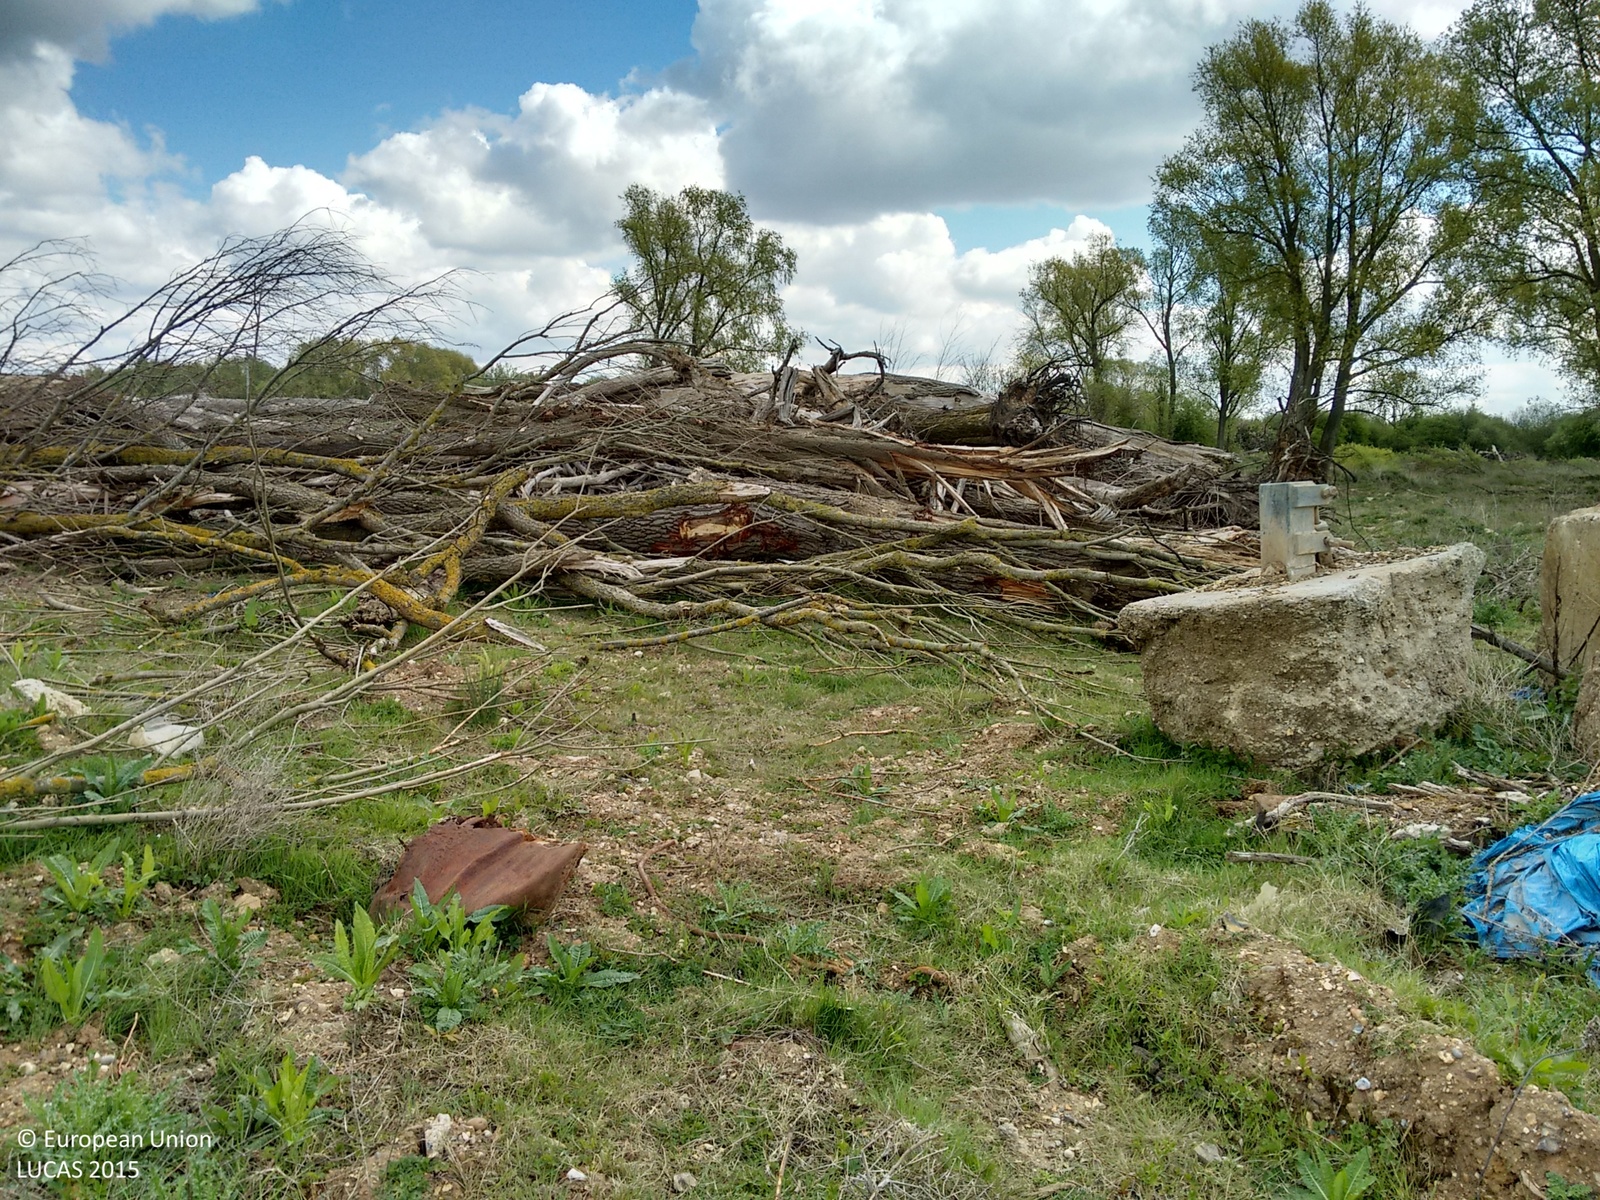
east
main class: Grassland
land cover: Spontaneously vegetated surfaces
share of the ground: > 75 %
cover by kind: herbaceous plants 90 %, unconsolidated bare surface 10 %
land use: Semi-natural and natural areas not in use
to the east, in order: Spontaneously vegetated surfaces; Grassland with sparse tree/shrub cover; Broadleaved woodland; Grassland with sparse tree/shrub cover
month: April
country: GB
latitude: 51.5103
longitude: -0.5137
